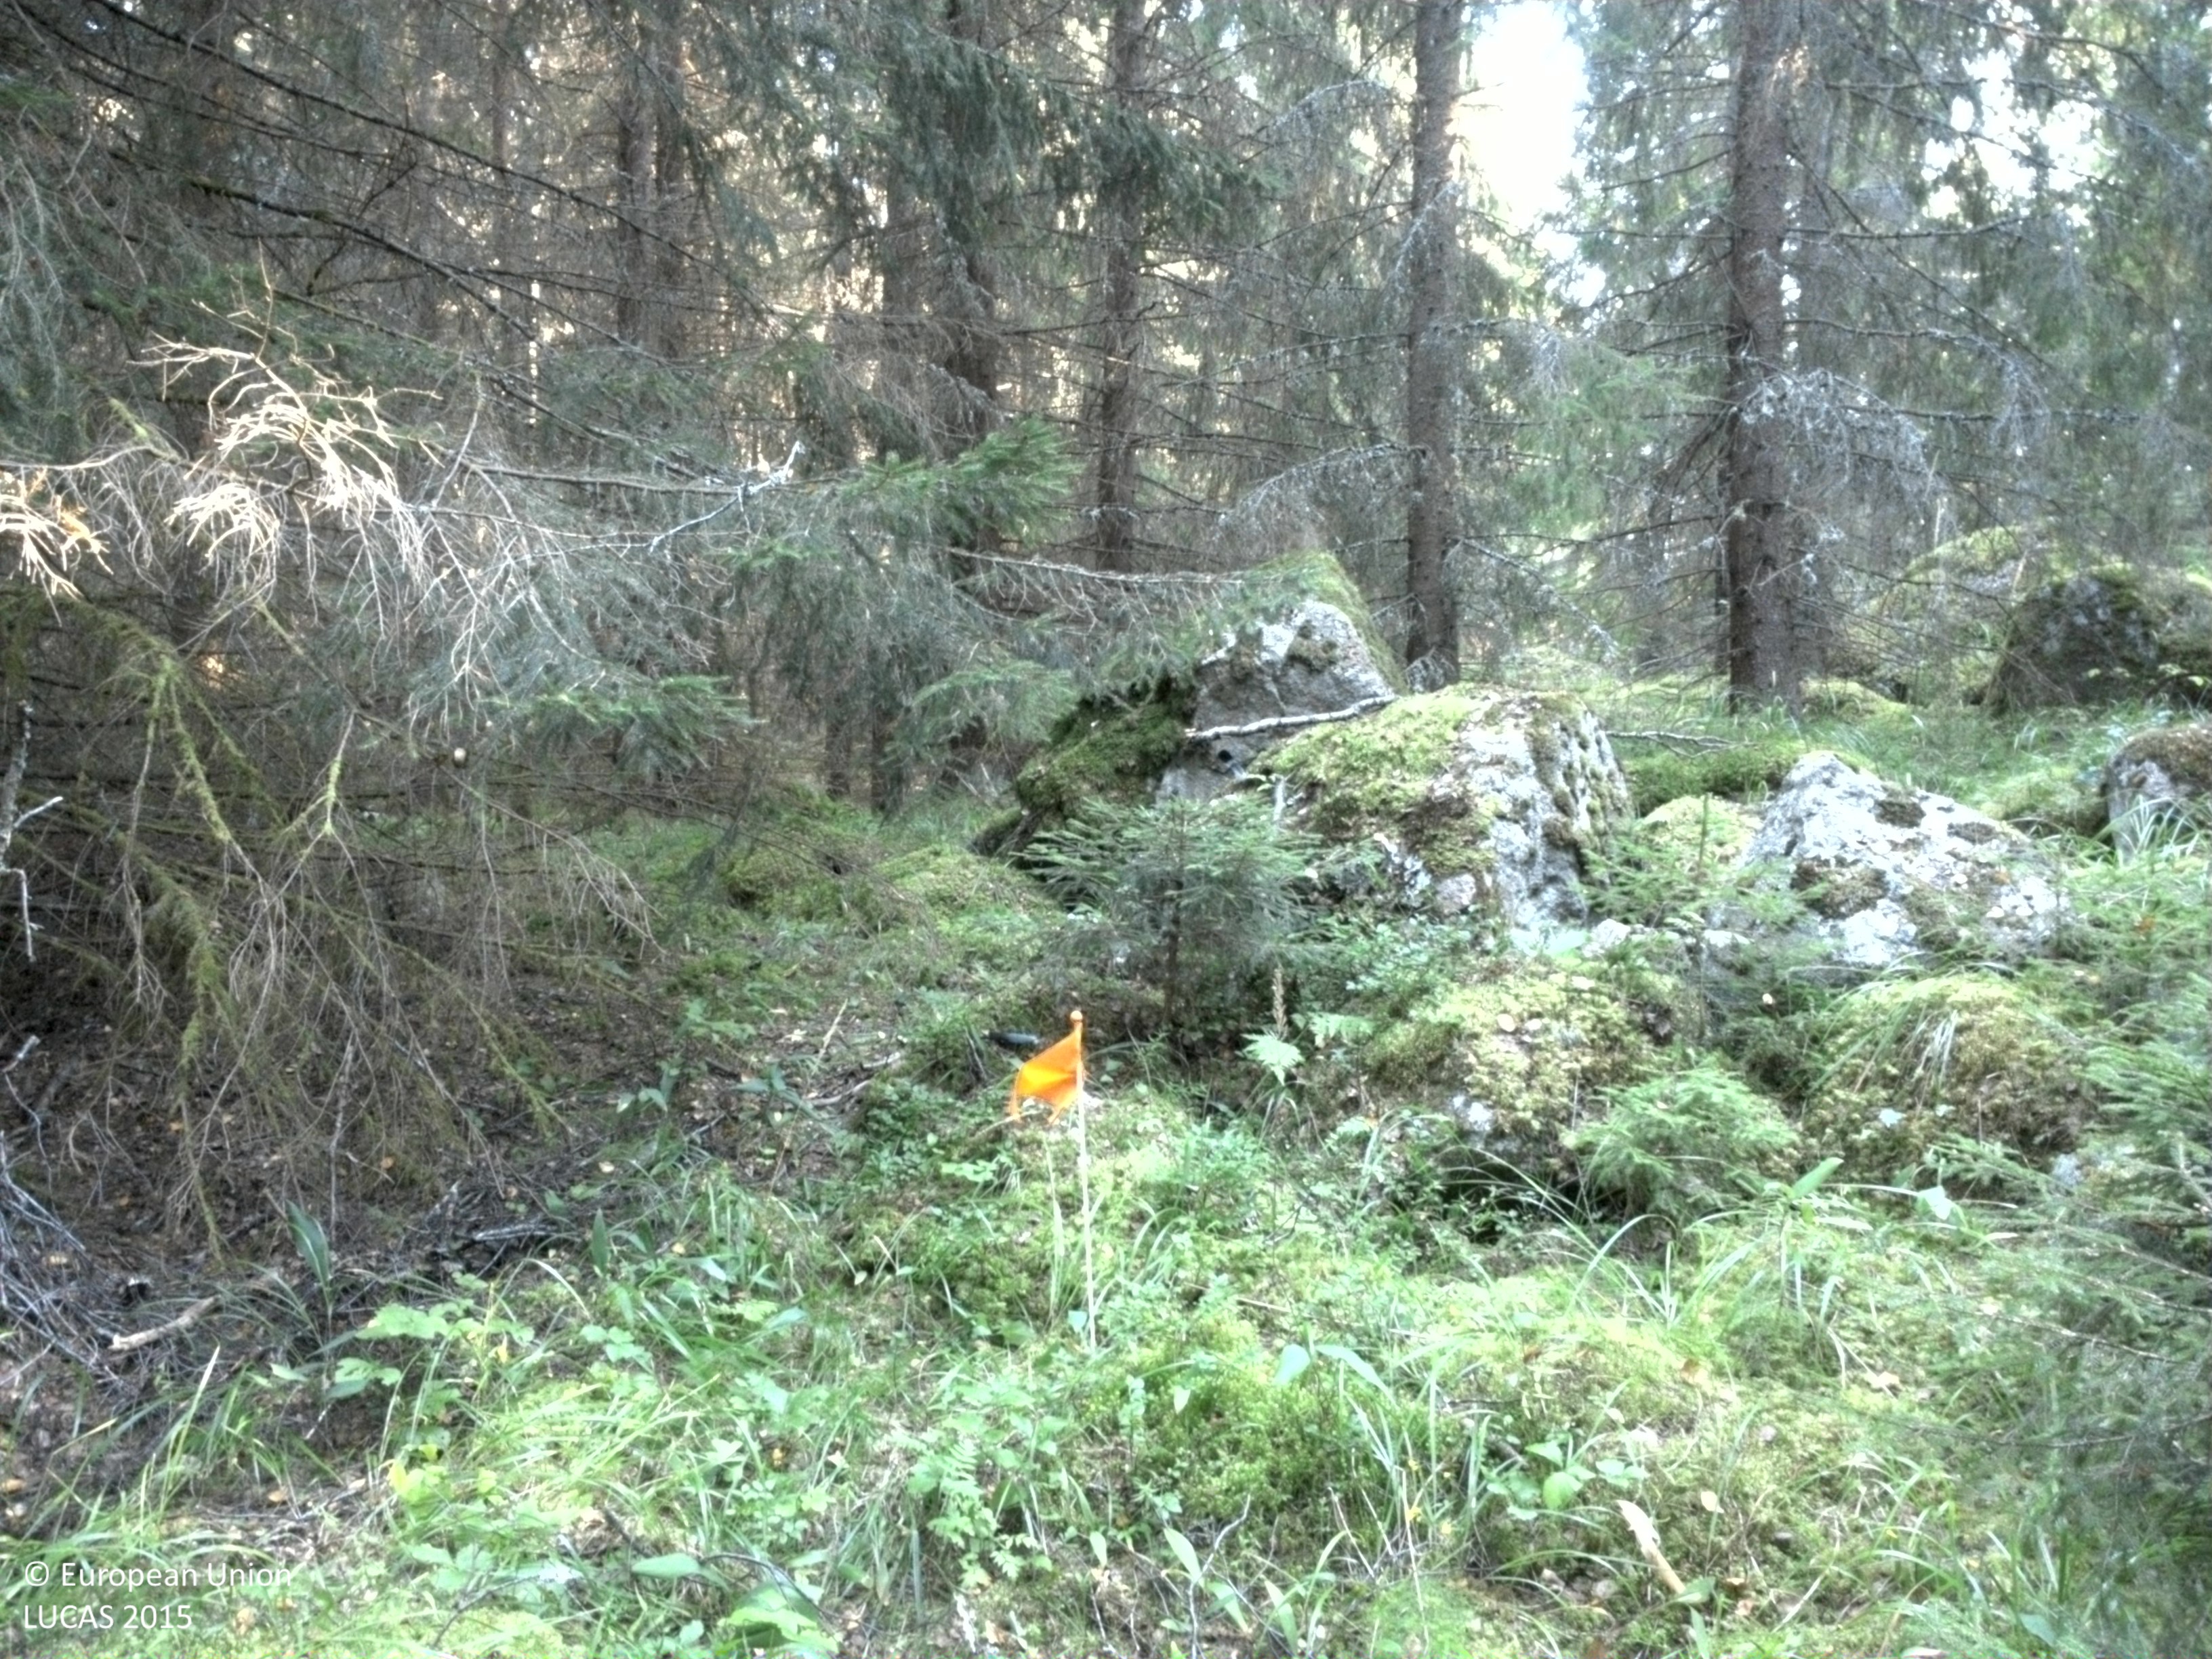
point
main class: Woodland
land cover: Spruce dominated mixed woodland
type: boreal forest
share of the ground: > 75 %
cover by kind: coniferous forest trees 55 %, broadleaved forest trees 20 %, lichens and mosses 15 %, herbaceous plants 5 %, consolidated bare surface 5 %
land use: Forestry
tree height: > 5 m
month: August
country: SE
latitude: 59.7481
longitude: 15.9520
